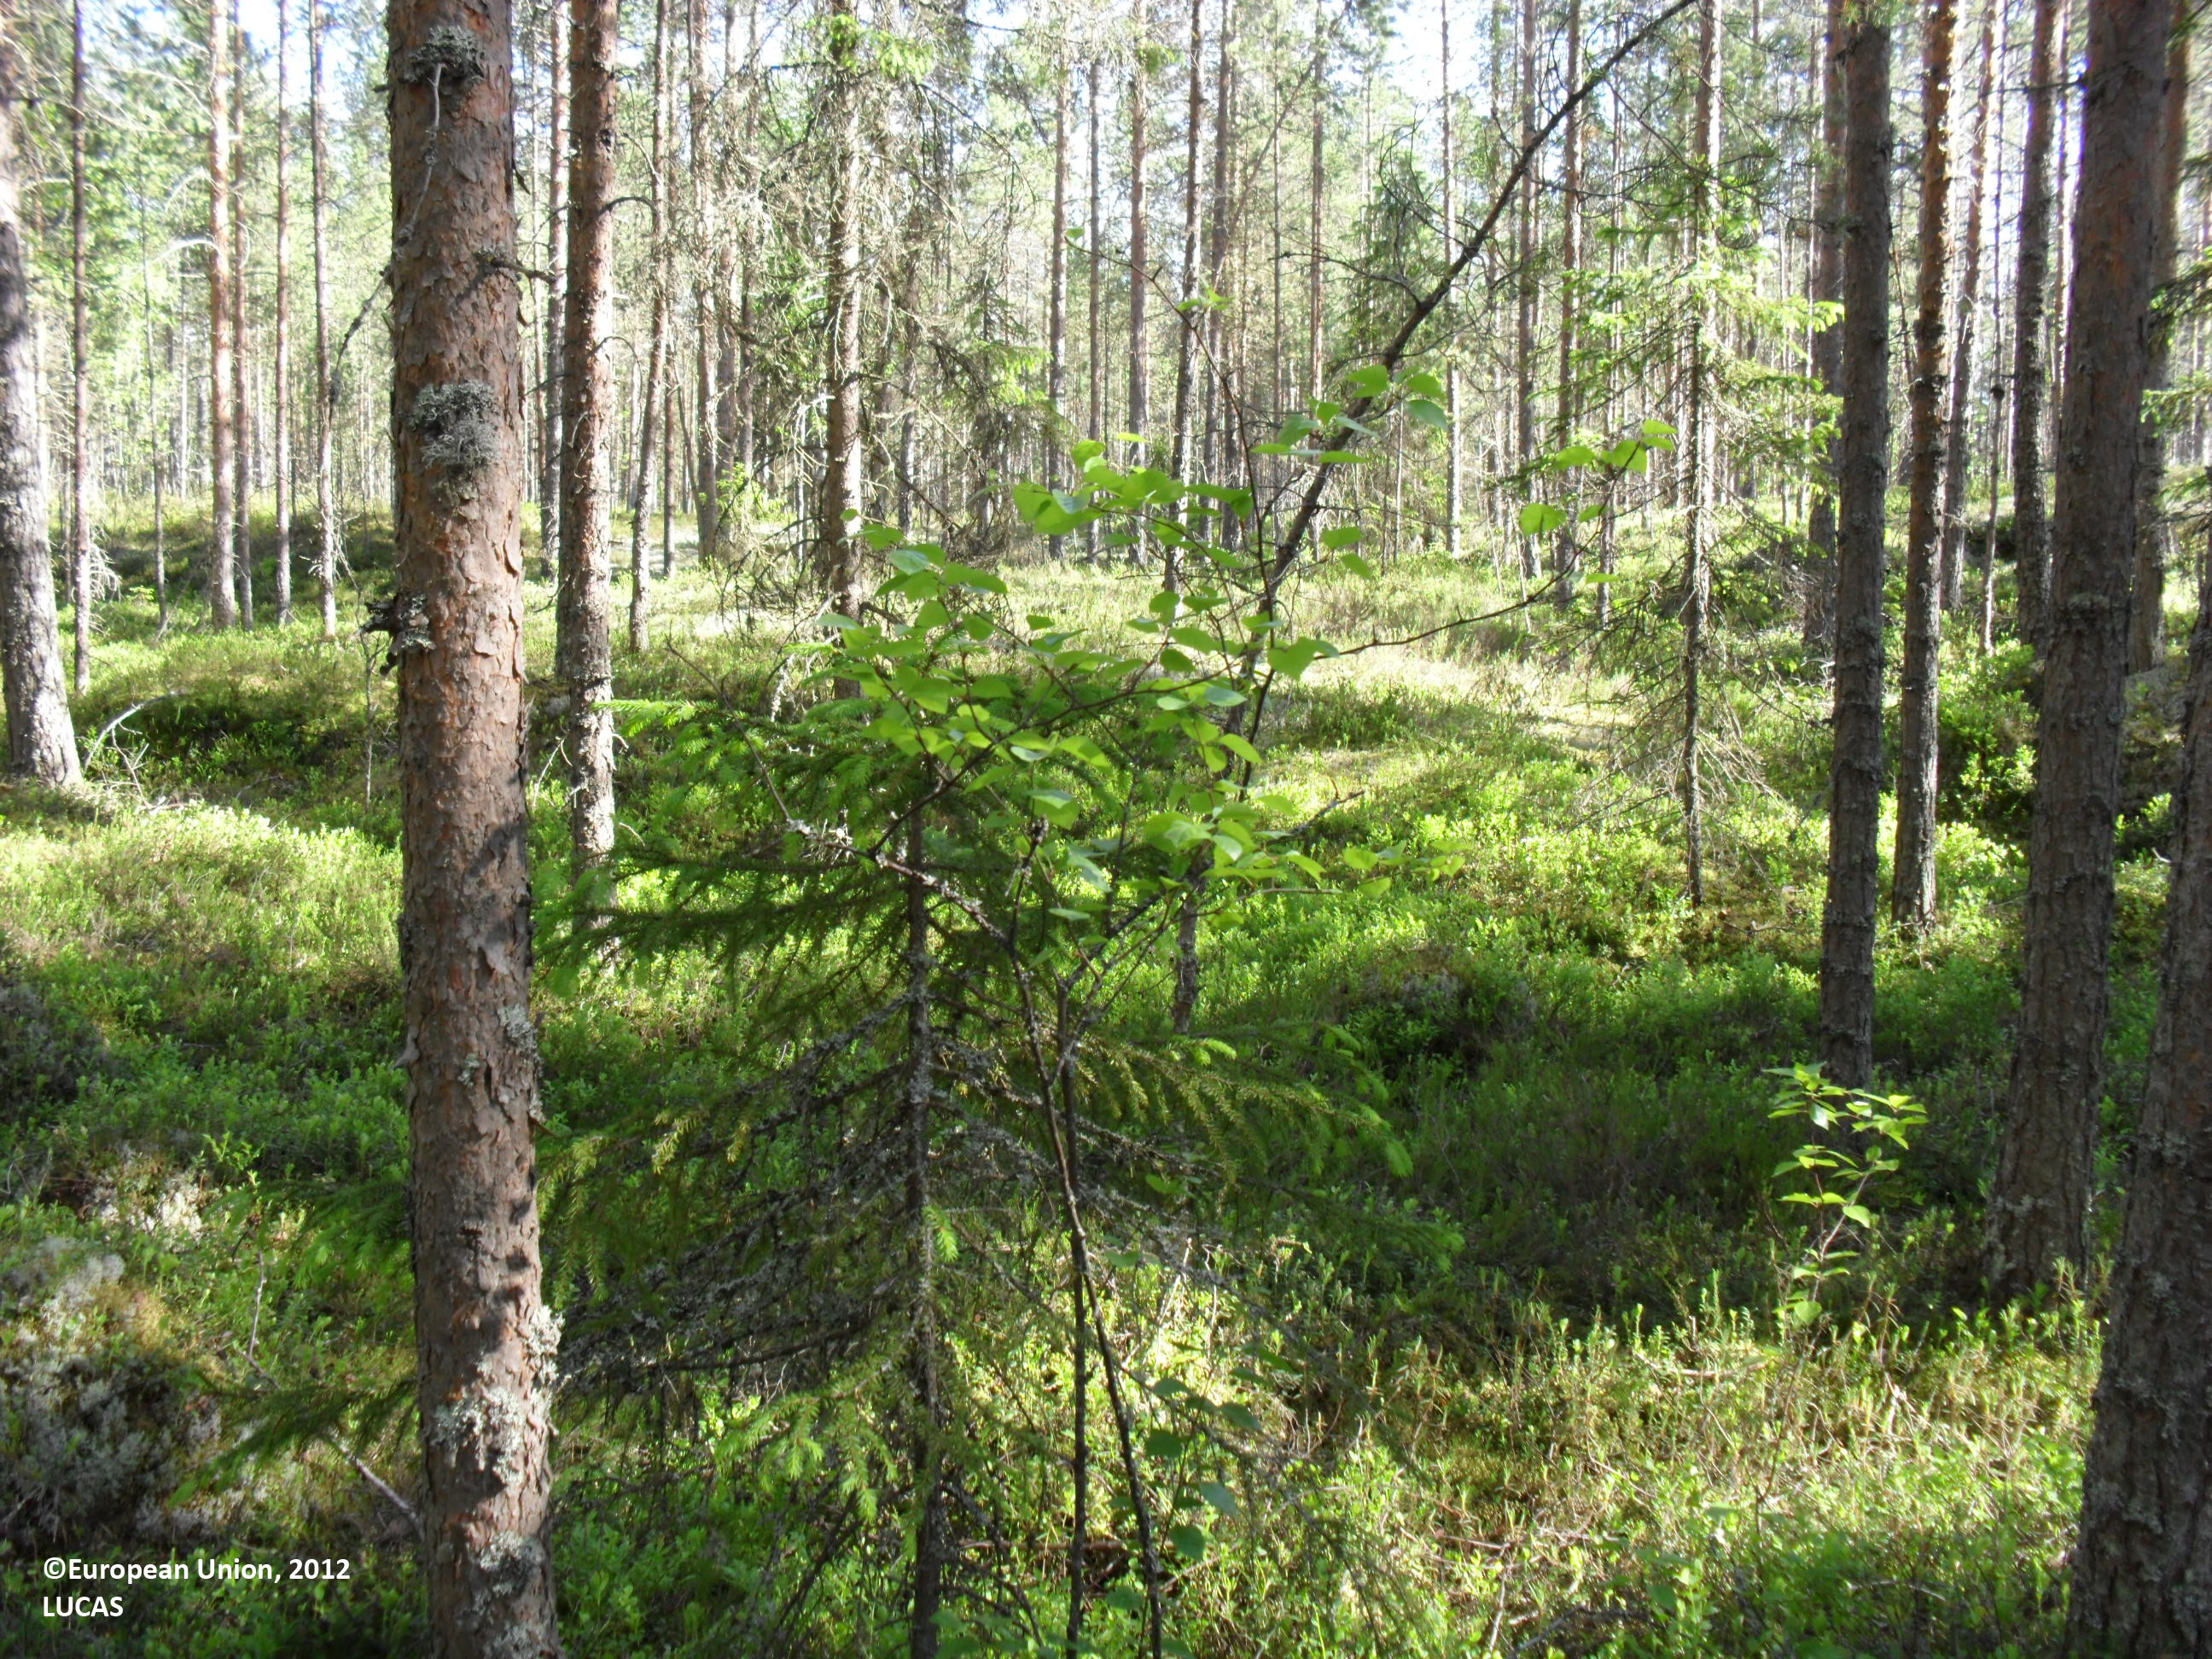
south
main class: Woodland
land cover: Pine dominated mixed woodland
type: boreal forest
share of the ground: 50 - 75 %
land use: Forestry
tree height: > 5 m
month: June
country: FI
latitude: 62.9482
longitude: 23.3684
